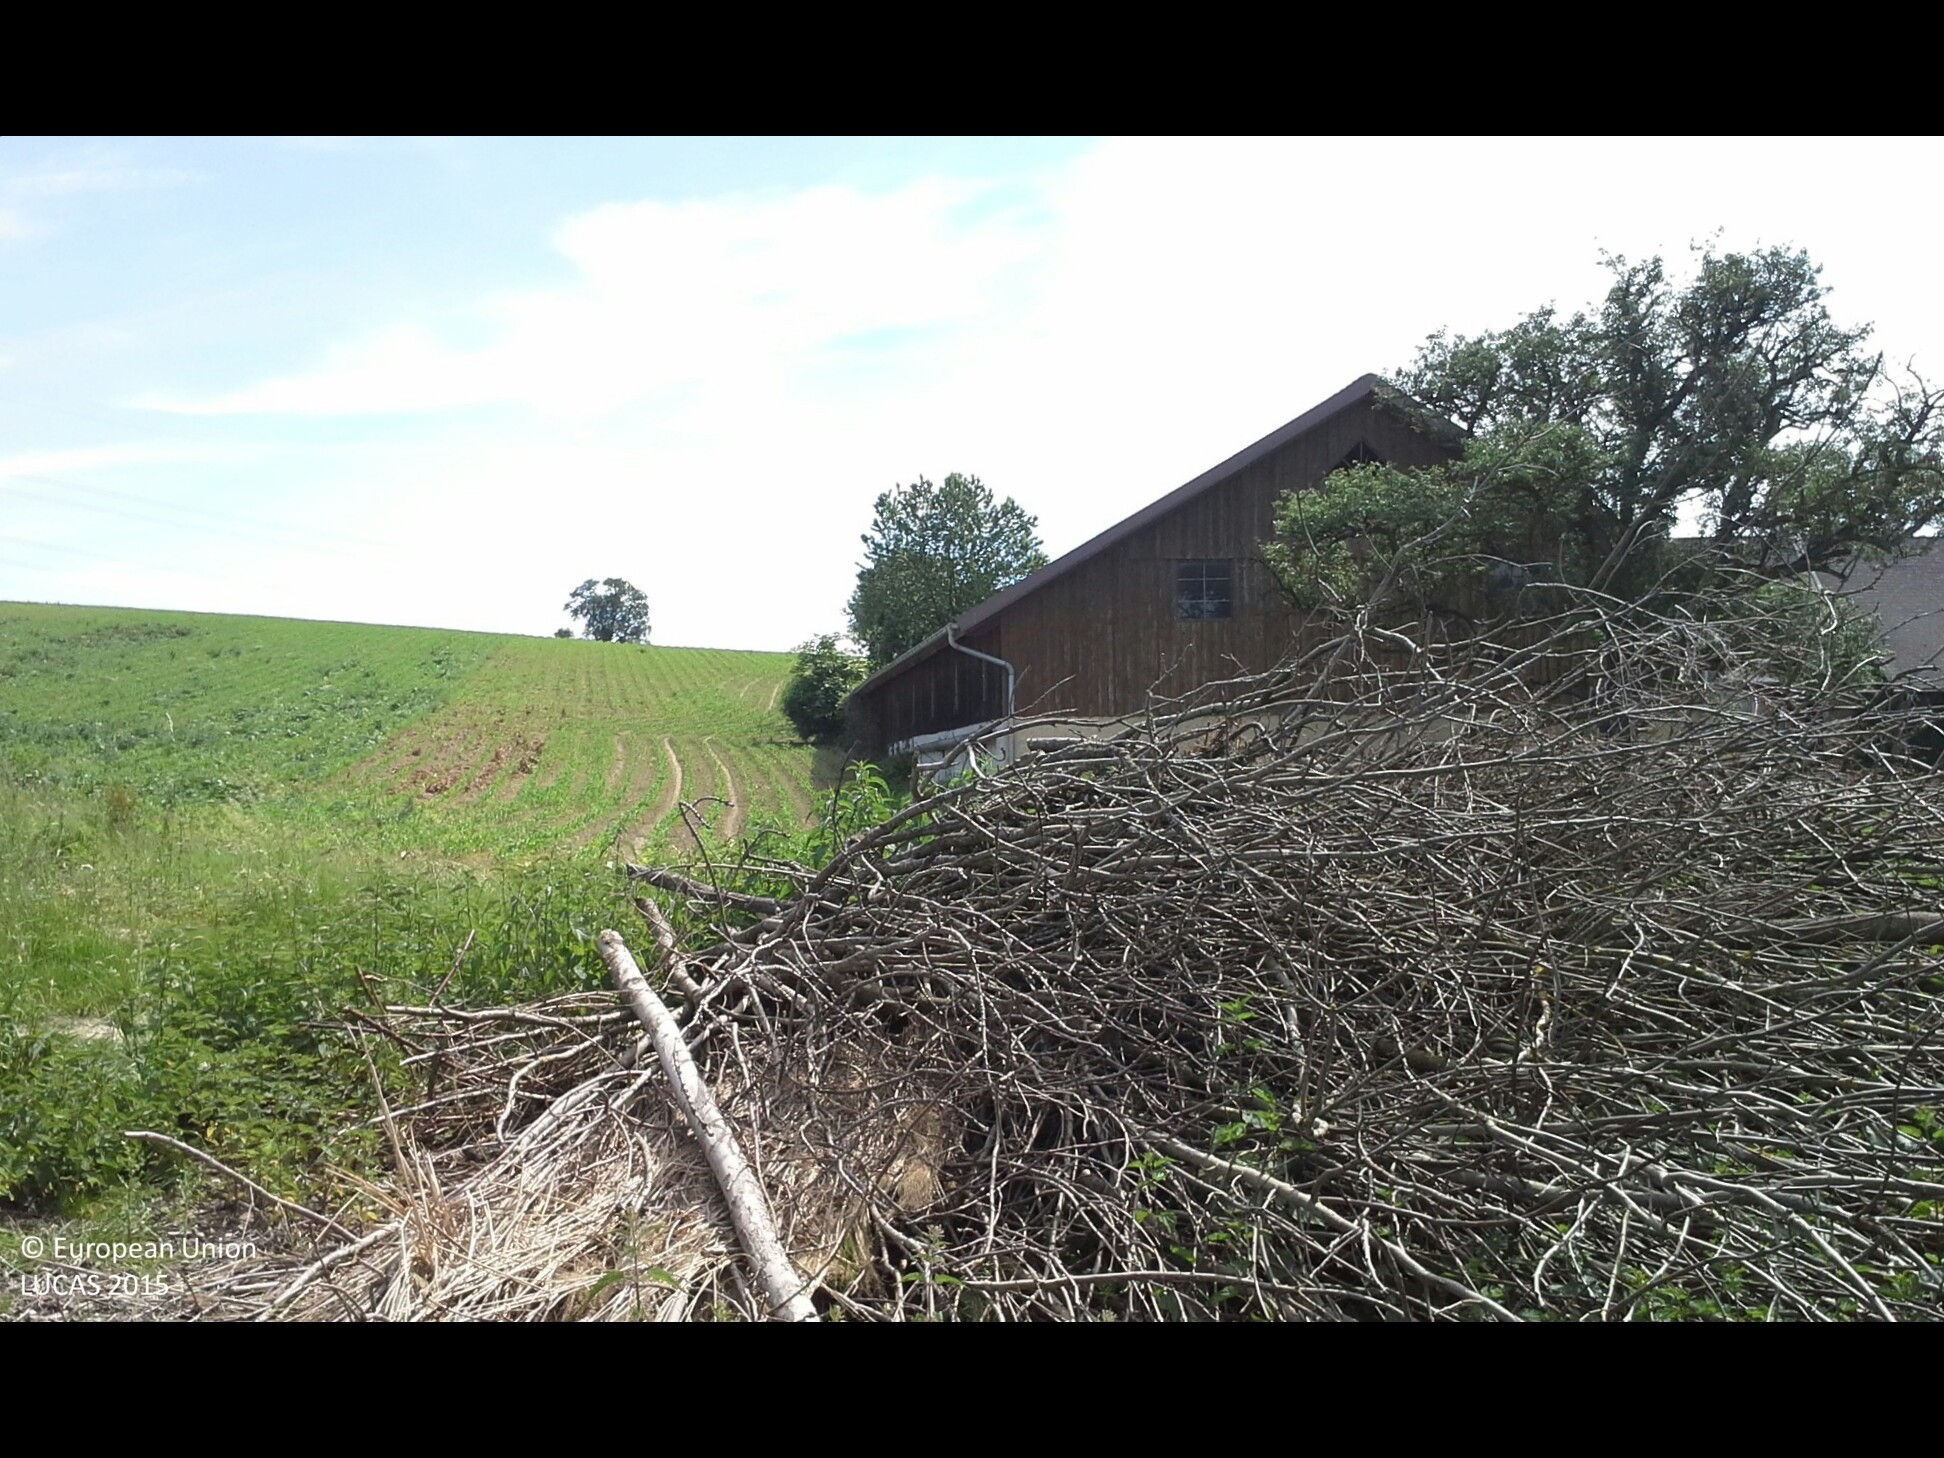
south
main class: Cropland
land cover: Common wheat
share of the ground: > 75 %
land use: Agriculture (excluding fallow land and kitchen gardens)
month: June
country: AT
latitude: 48.1539
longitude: 14.8266
